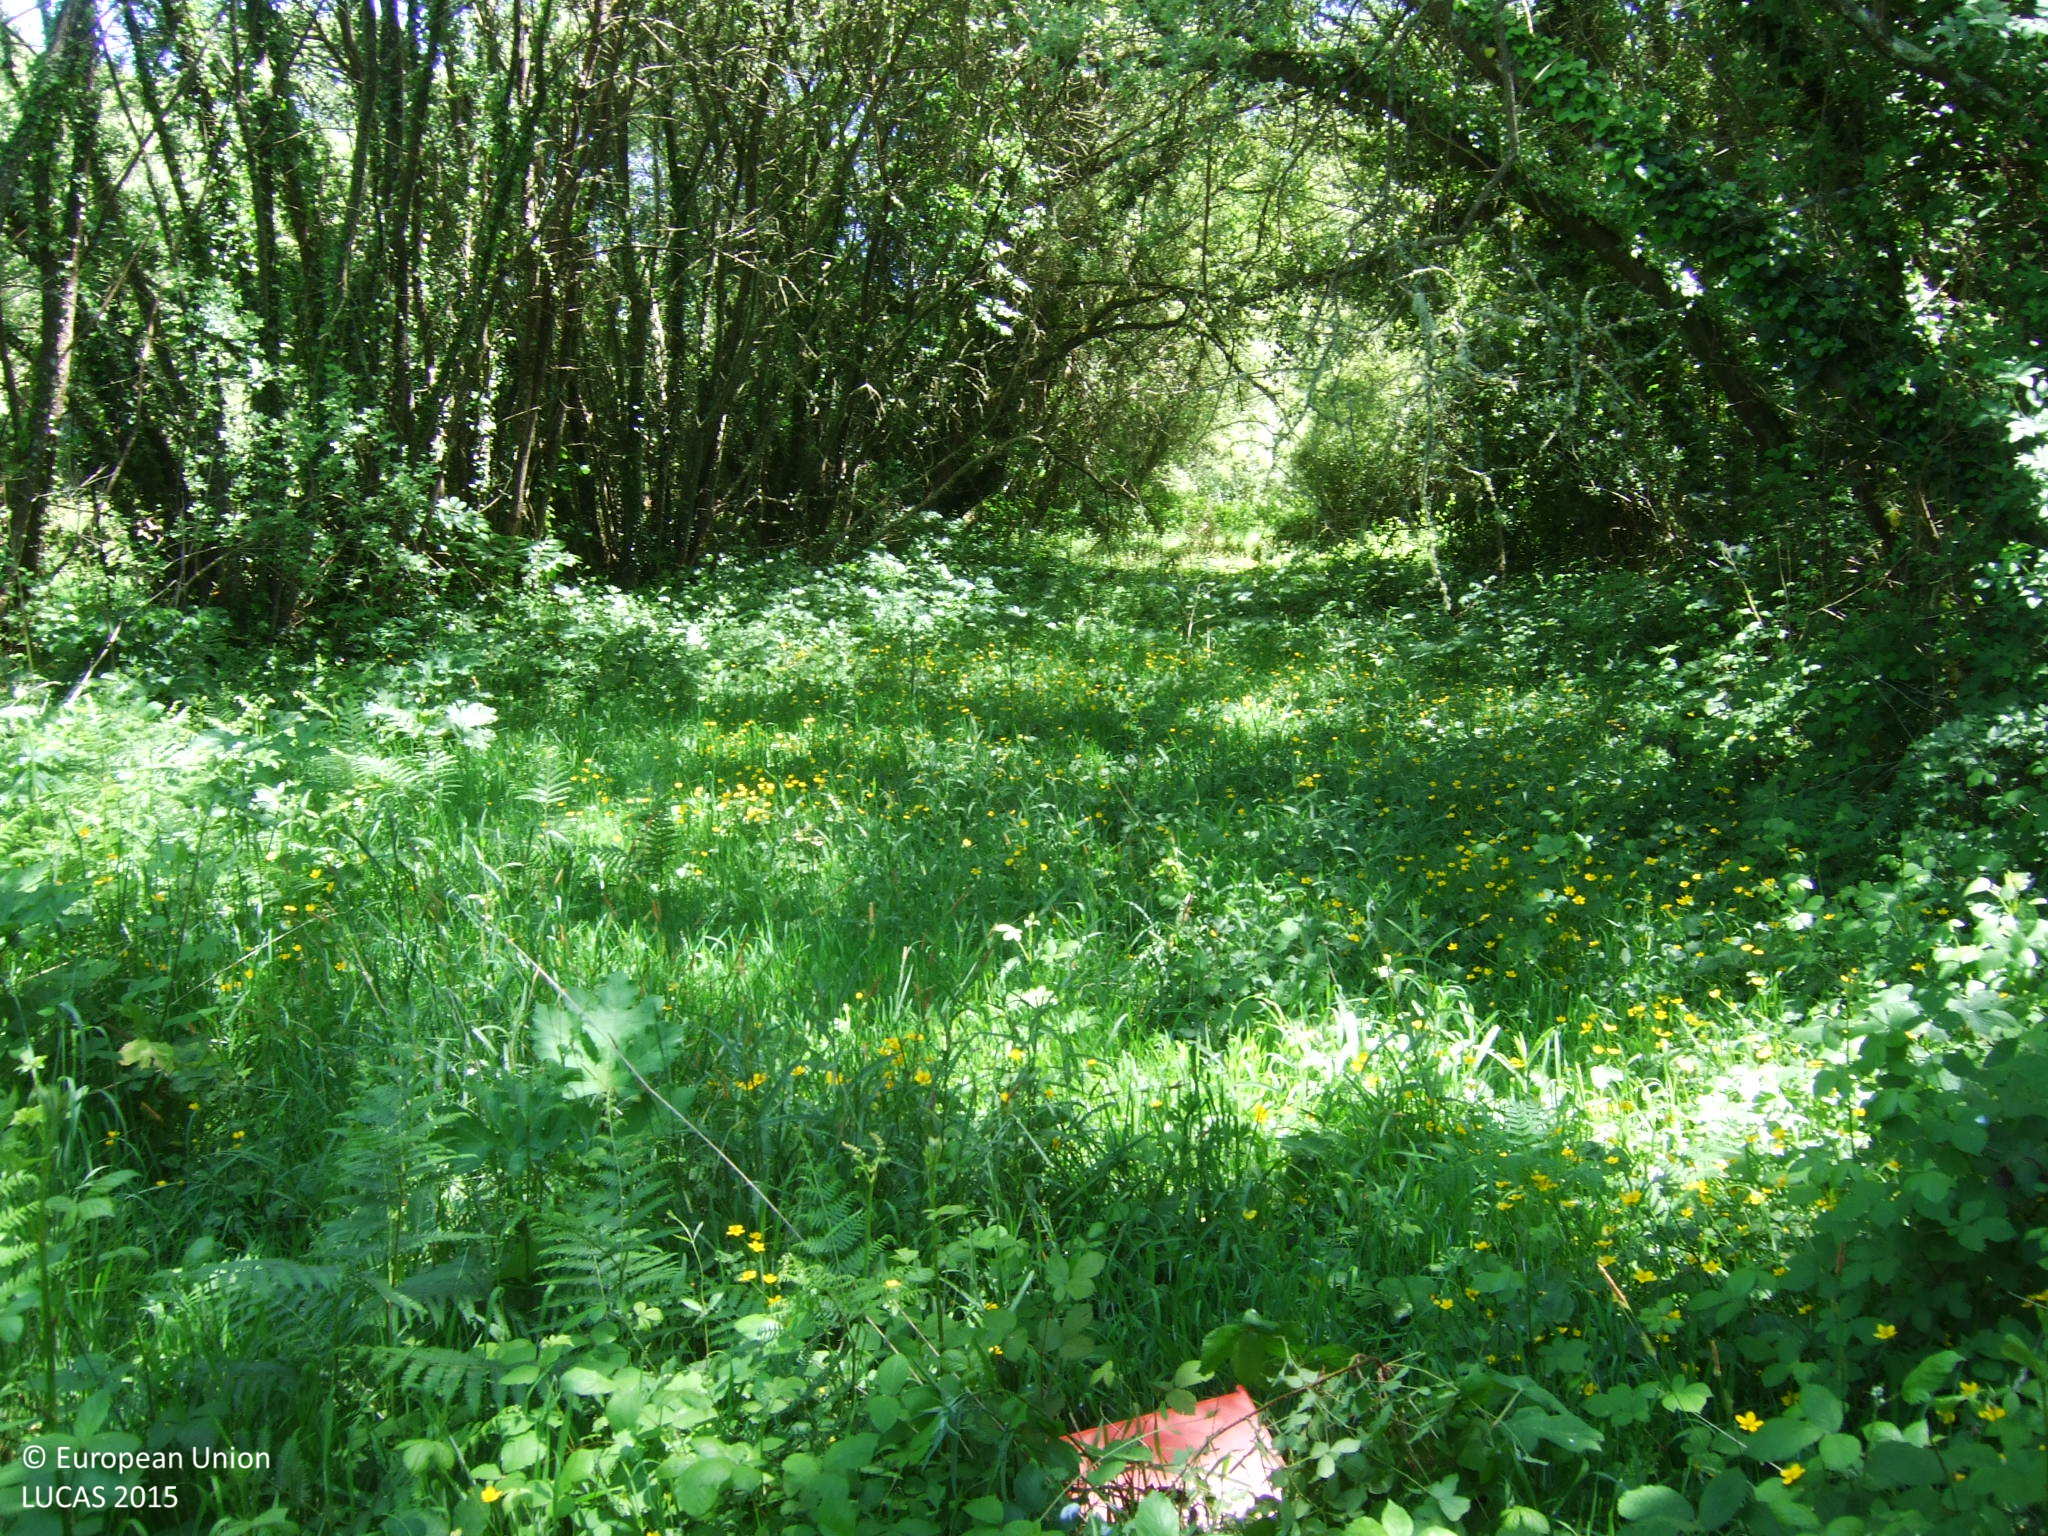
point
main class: Grassland
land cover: Grassland without tree/shrub cover
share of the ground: > 75 %
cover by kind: herbaceous plants 100 %
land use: Agriculture (excluding fallow land and kitchen gardens)
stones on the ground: < 10 %
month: May
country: ES
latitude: 43.2412
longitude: -7.6818
